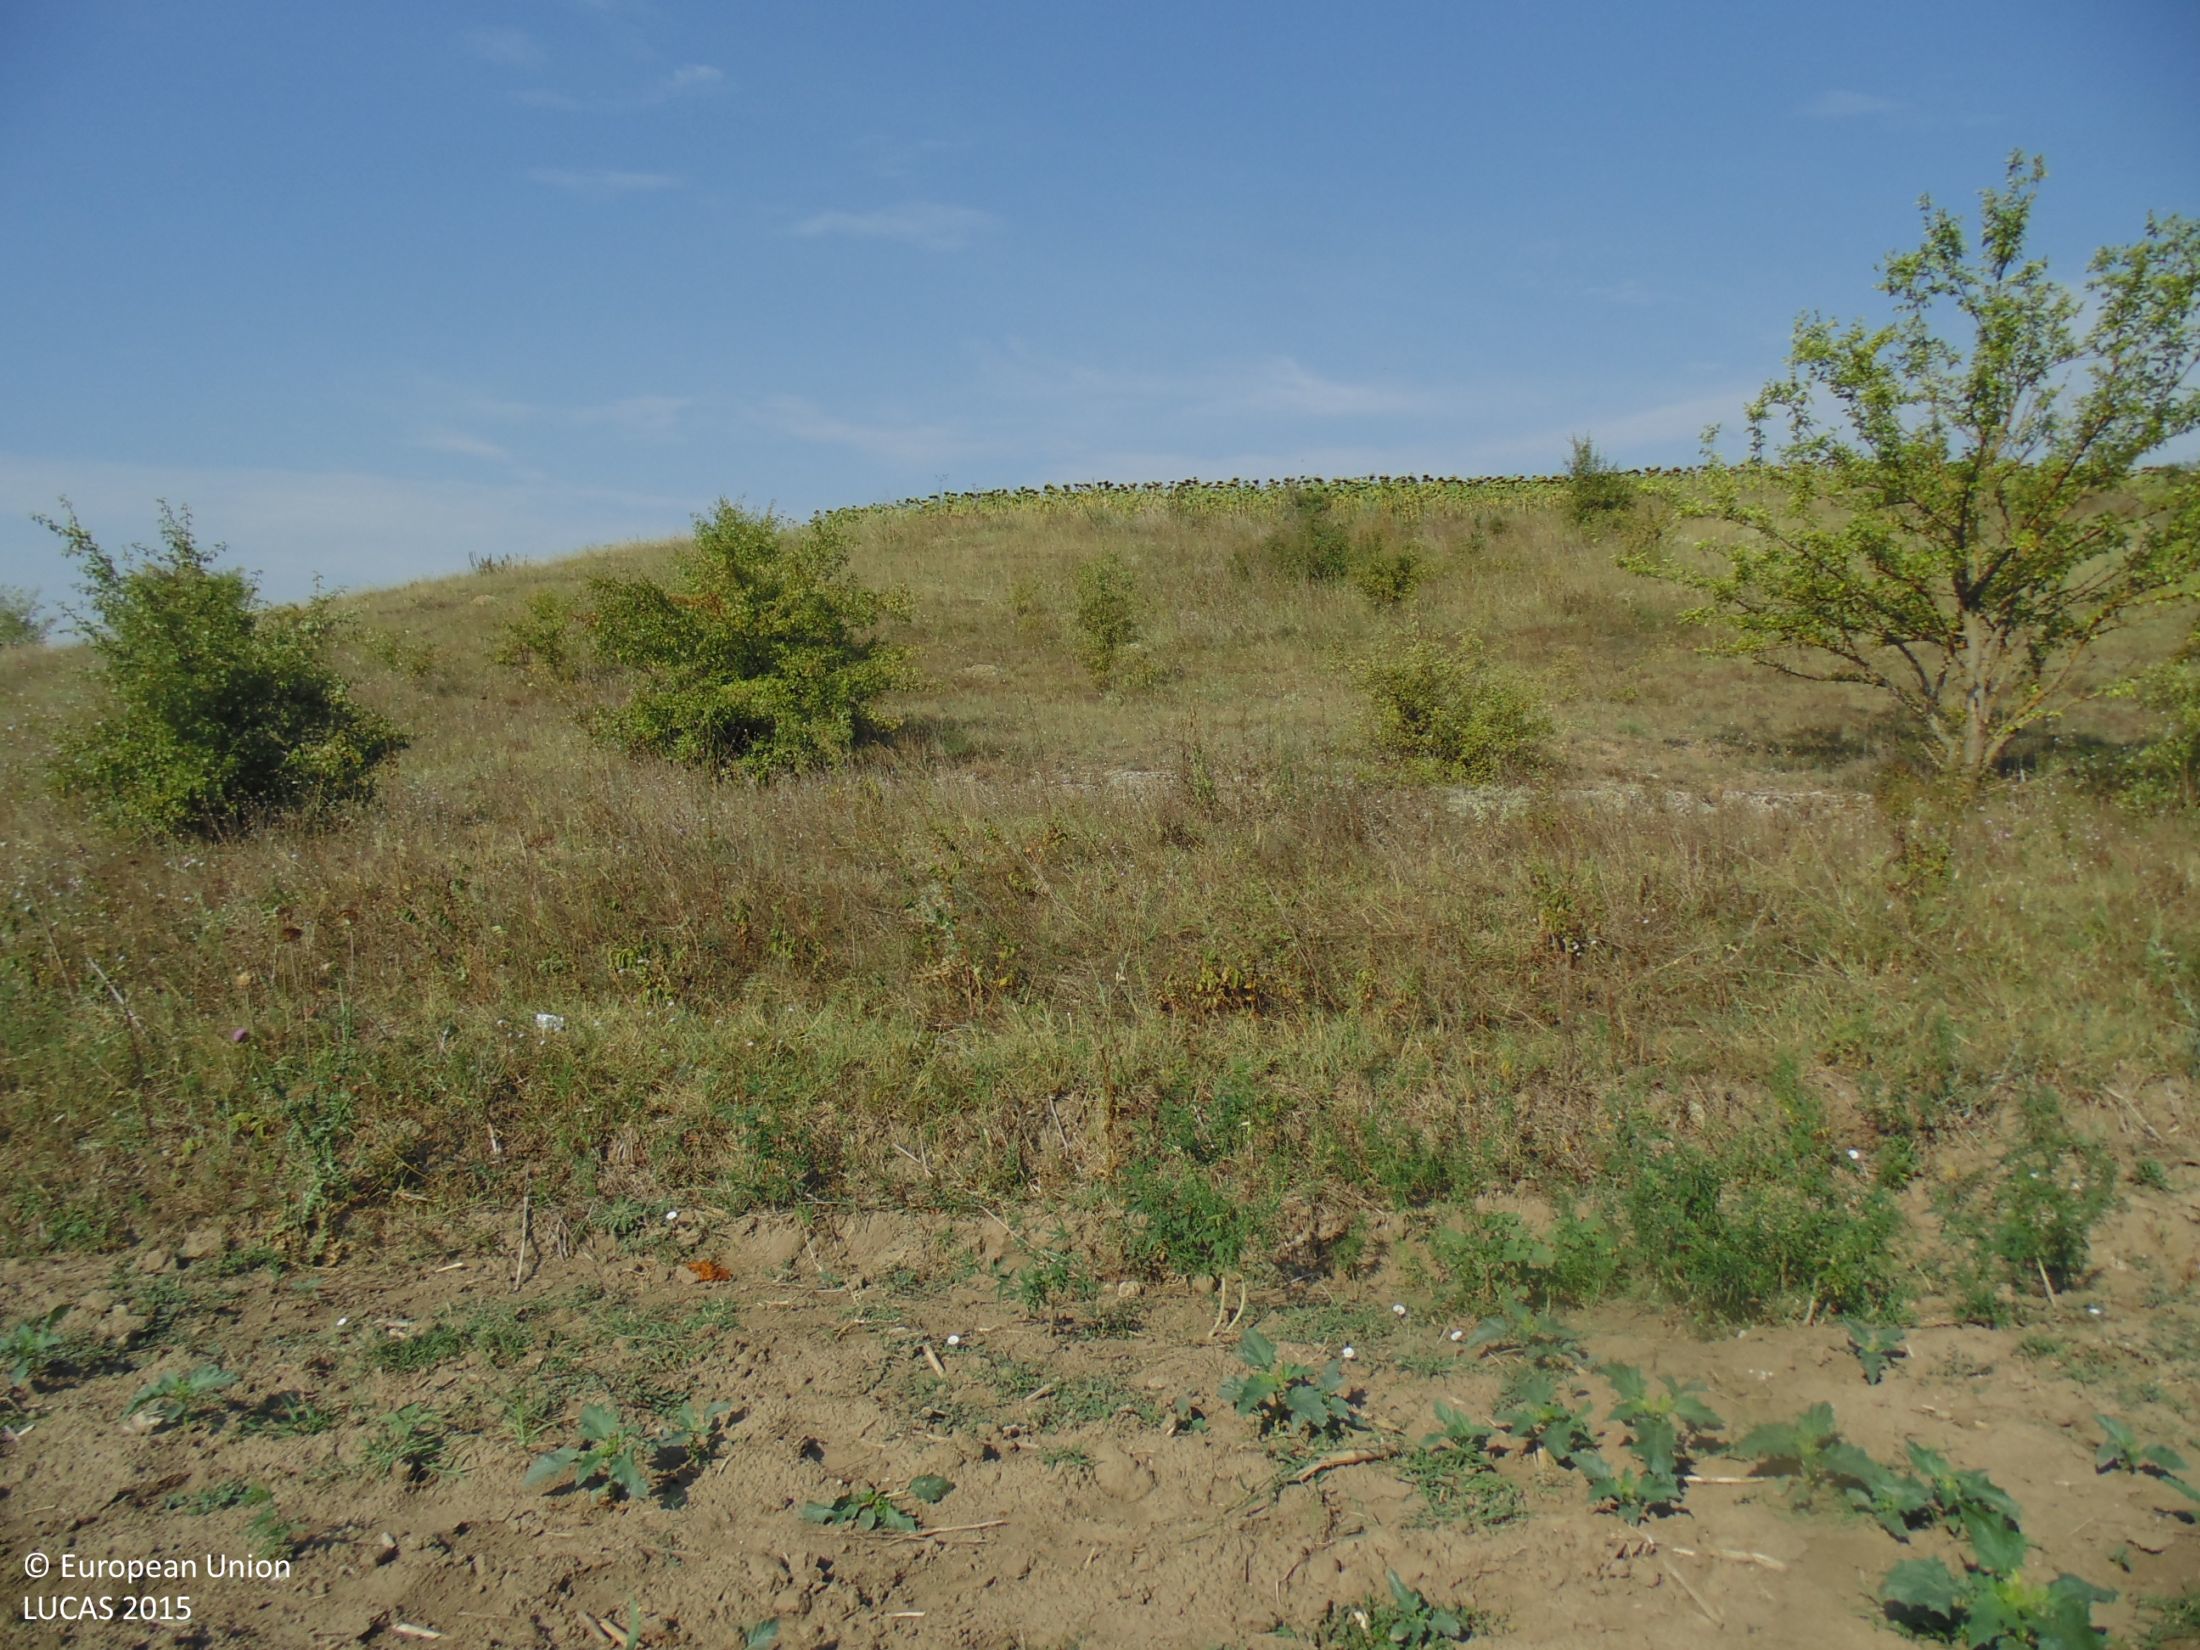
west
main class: Grassland
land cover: Spontaneously vegetated surfaces
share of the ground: 50 - 75 %
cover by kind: herbaceous plants 70 %, unconsolidated bare surface 30 %
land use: Fallow land
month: August
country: BG
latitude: 43.8740
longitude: 27.7520
